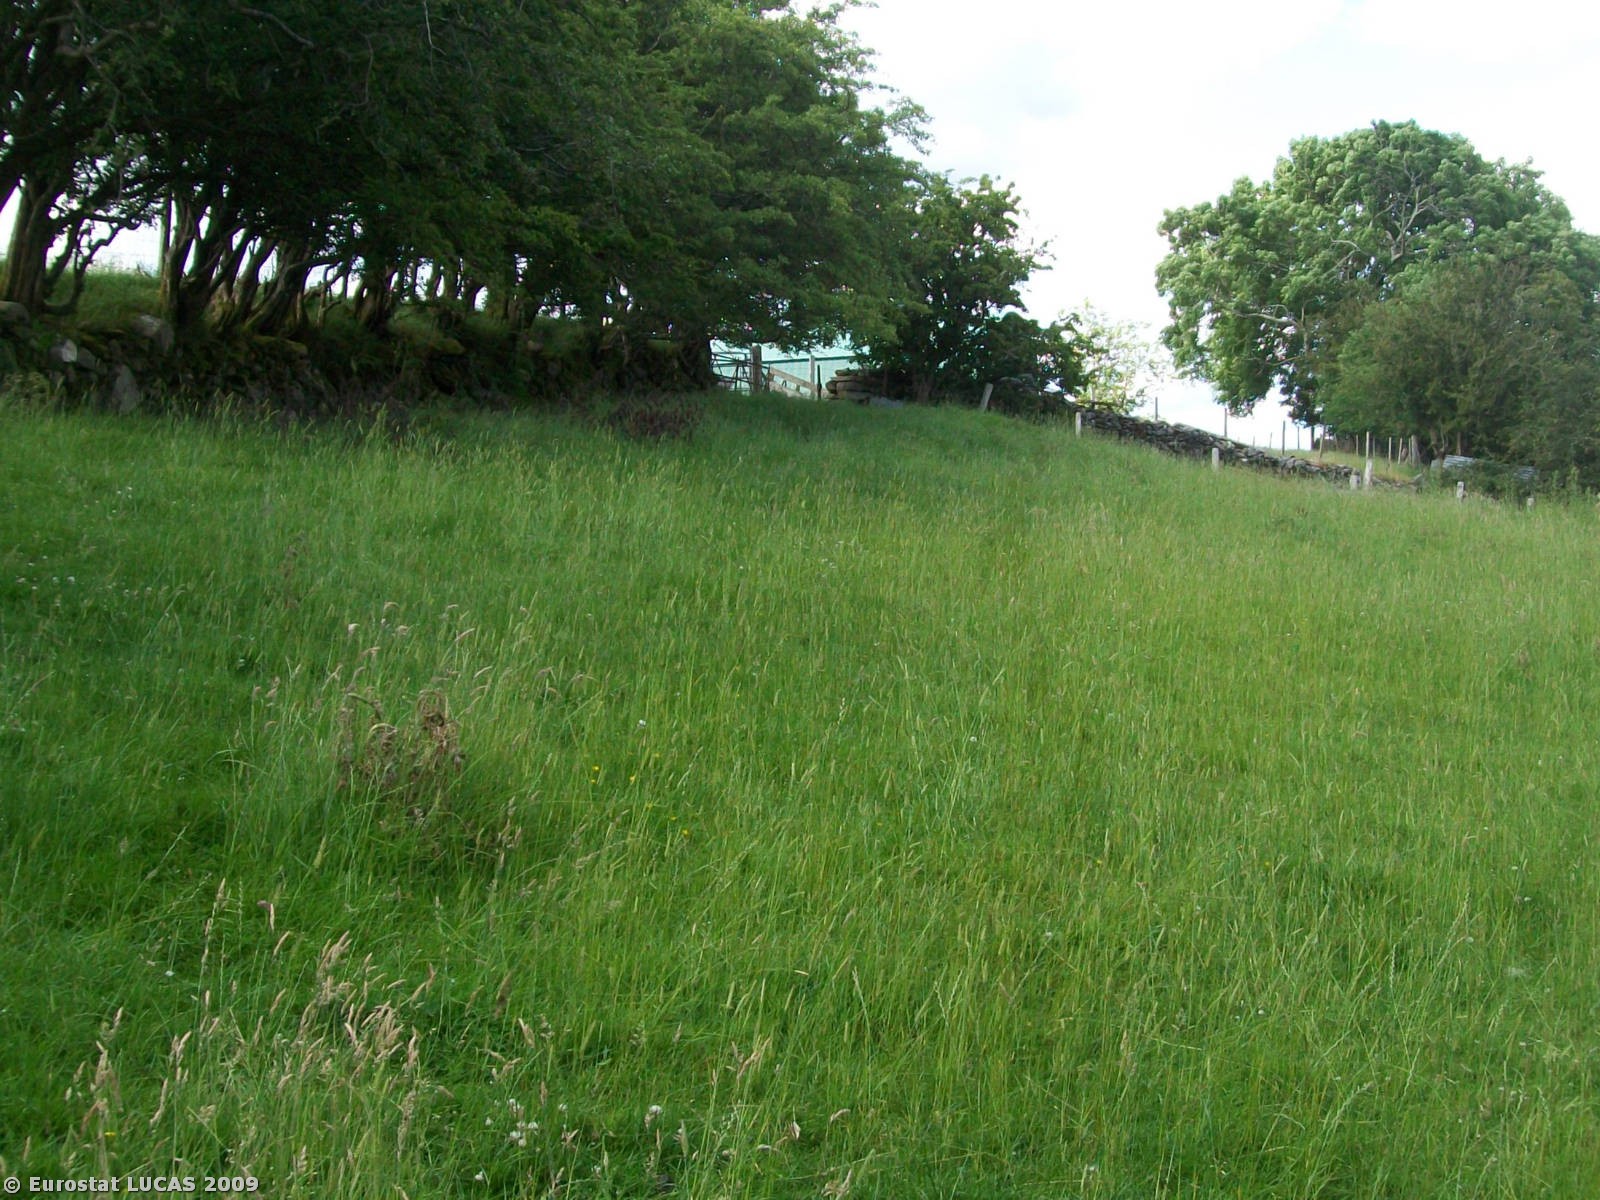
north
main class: Grassland
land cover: Grassland without tree/shrub cover
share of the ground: > 75 %
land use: Agriculture (excluding fallow land and kitchen gardens)
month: July
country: GB
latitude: 54.8724
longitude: -7.0158
